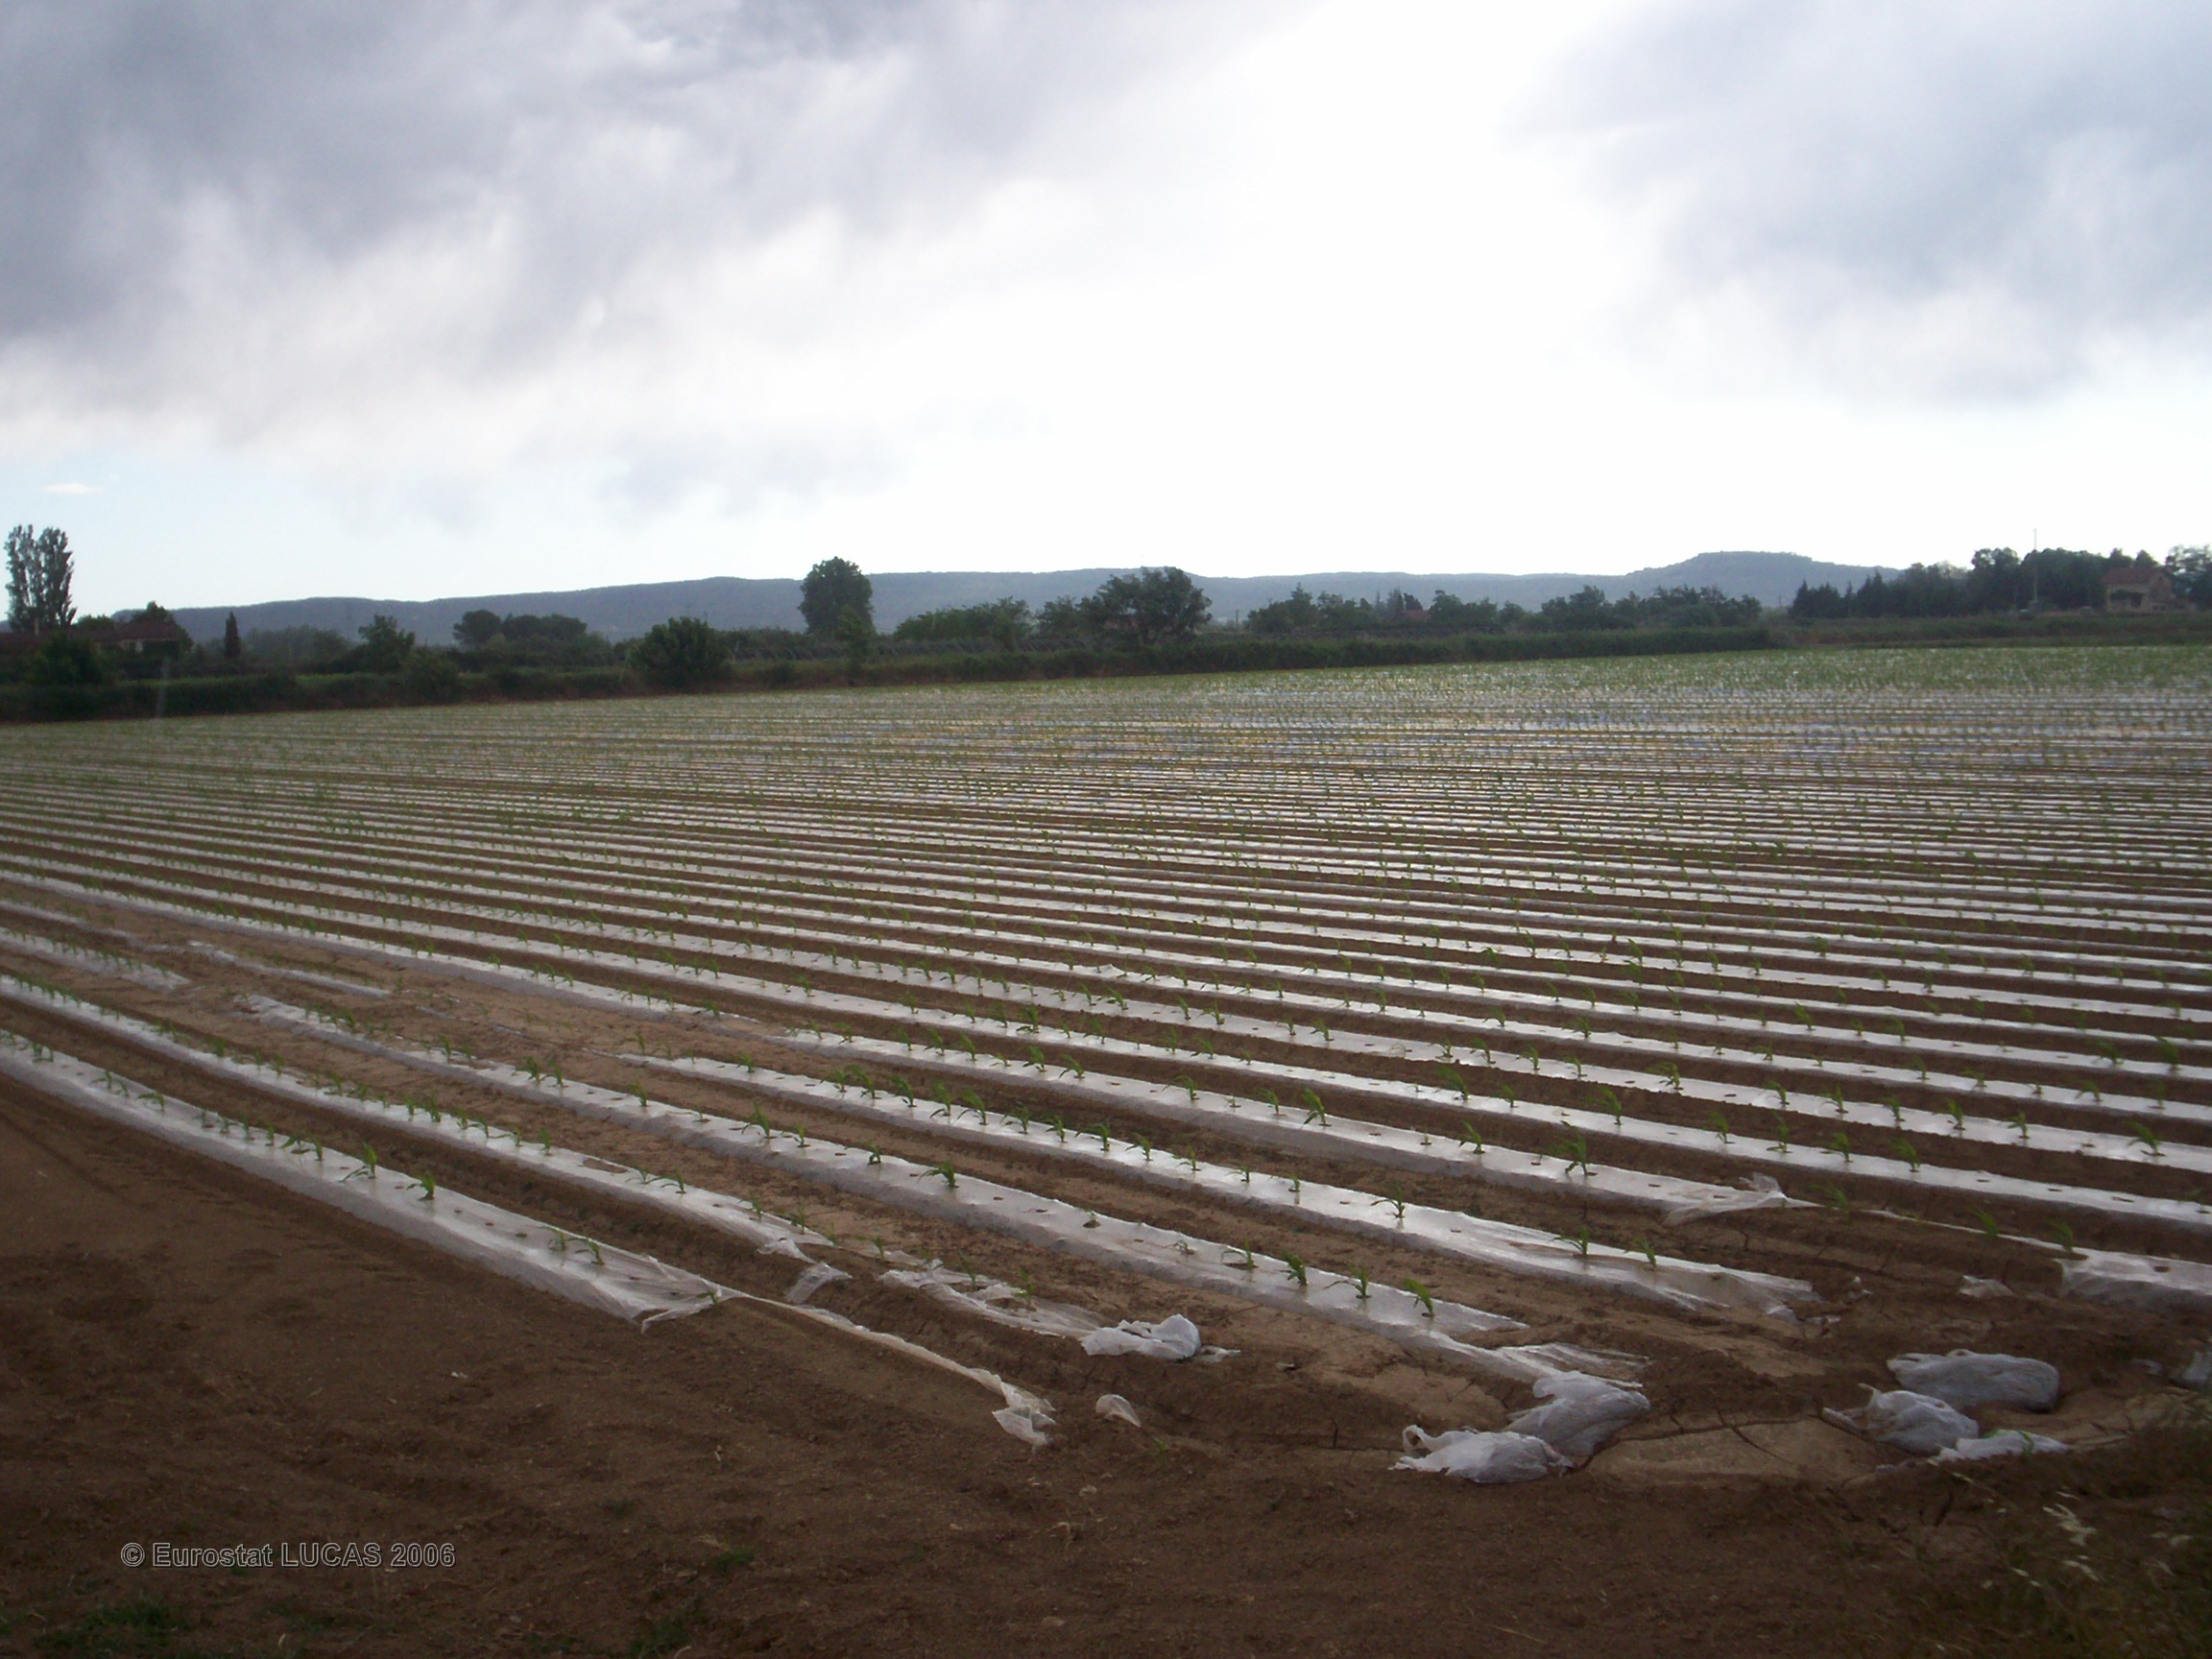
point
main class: Cropland
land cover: Maize
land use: Agriculture (excluding fallow land and kitchen gardens)
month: June
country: FR
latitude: 43.6762
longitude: 5.5315
